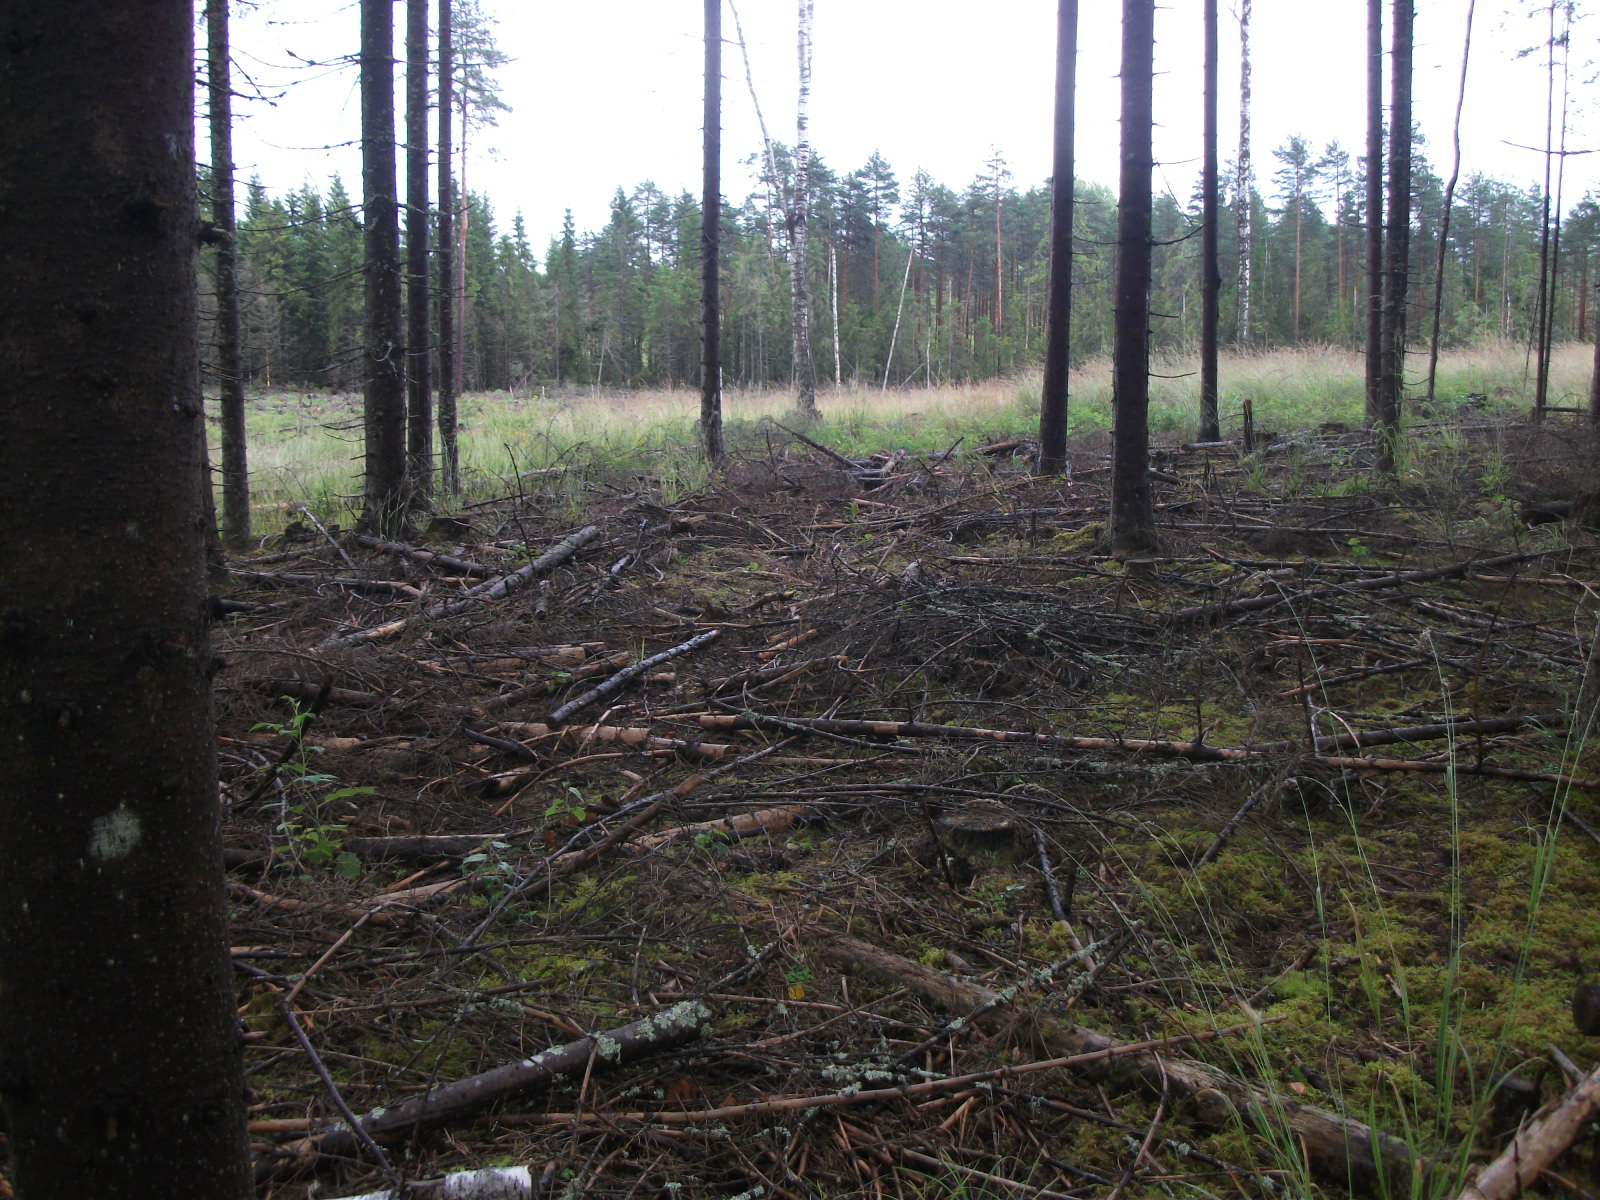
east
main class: Woodland
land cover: Spruce dominated coniferous woodland
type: hemiboreal forest and nemoral coniferous forest and mixed broadleaved-coniferous forest
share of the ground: 50 - 75 %
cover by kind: coniferous forest trees 60 %, herbaceous plants 15 %, lichens and mosses 15 %, unconsolidated bare surface 5 %
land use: Forestry
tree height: > 5 m
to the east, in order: Spruce dominated coniferous woodland; Spontaneously vegetated surfaces; Grassland with sparse tree/shrub cover; Spontaneously vegetated surfaces; Spruce dominated coniferous woodland
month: July
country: LV
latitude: 56.9729
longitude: 25.8711
